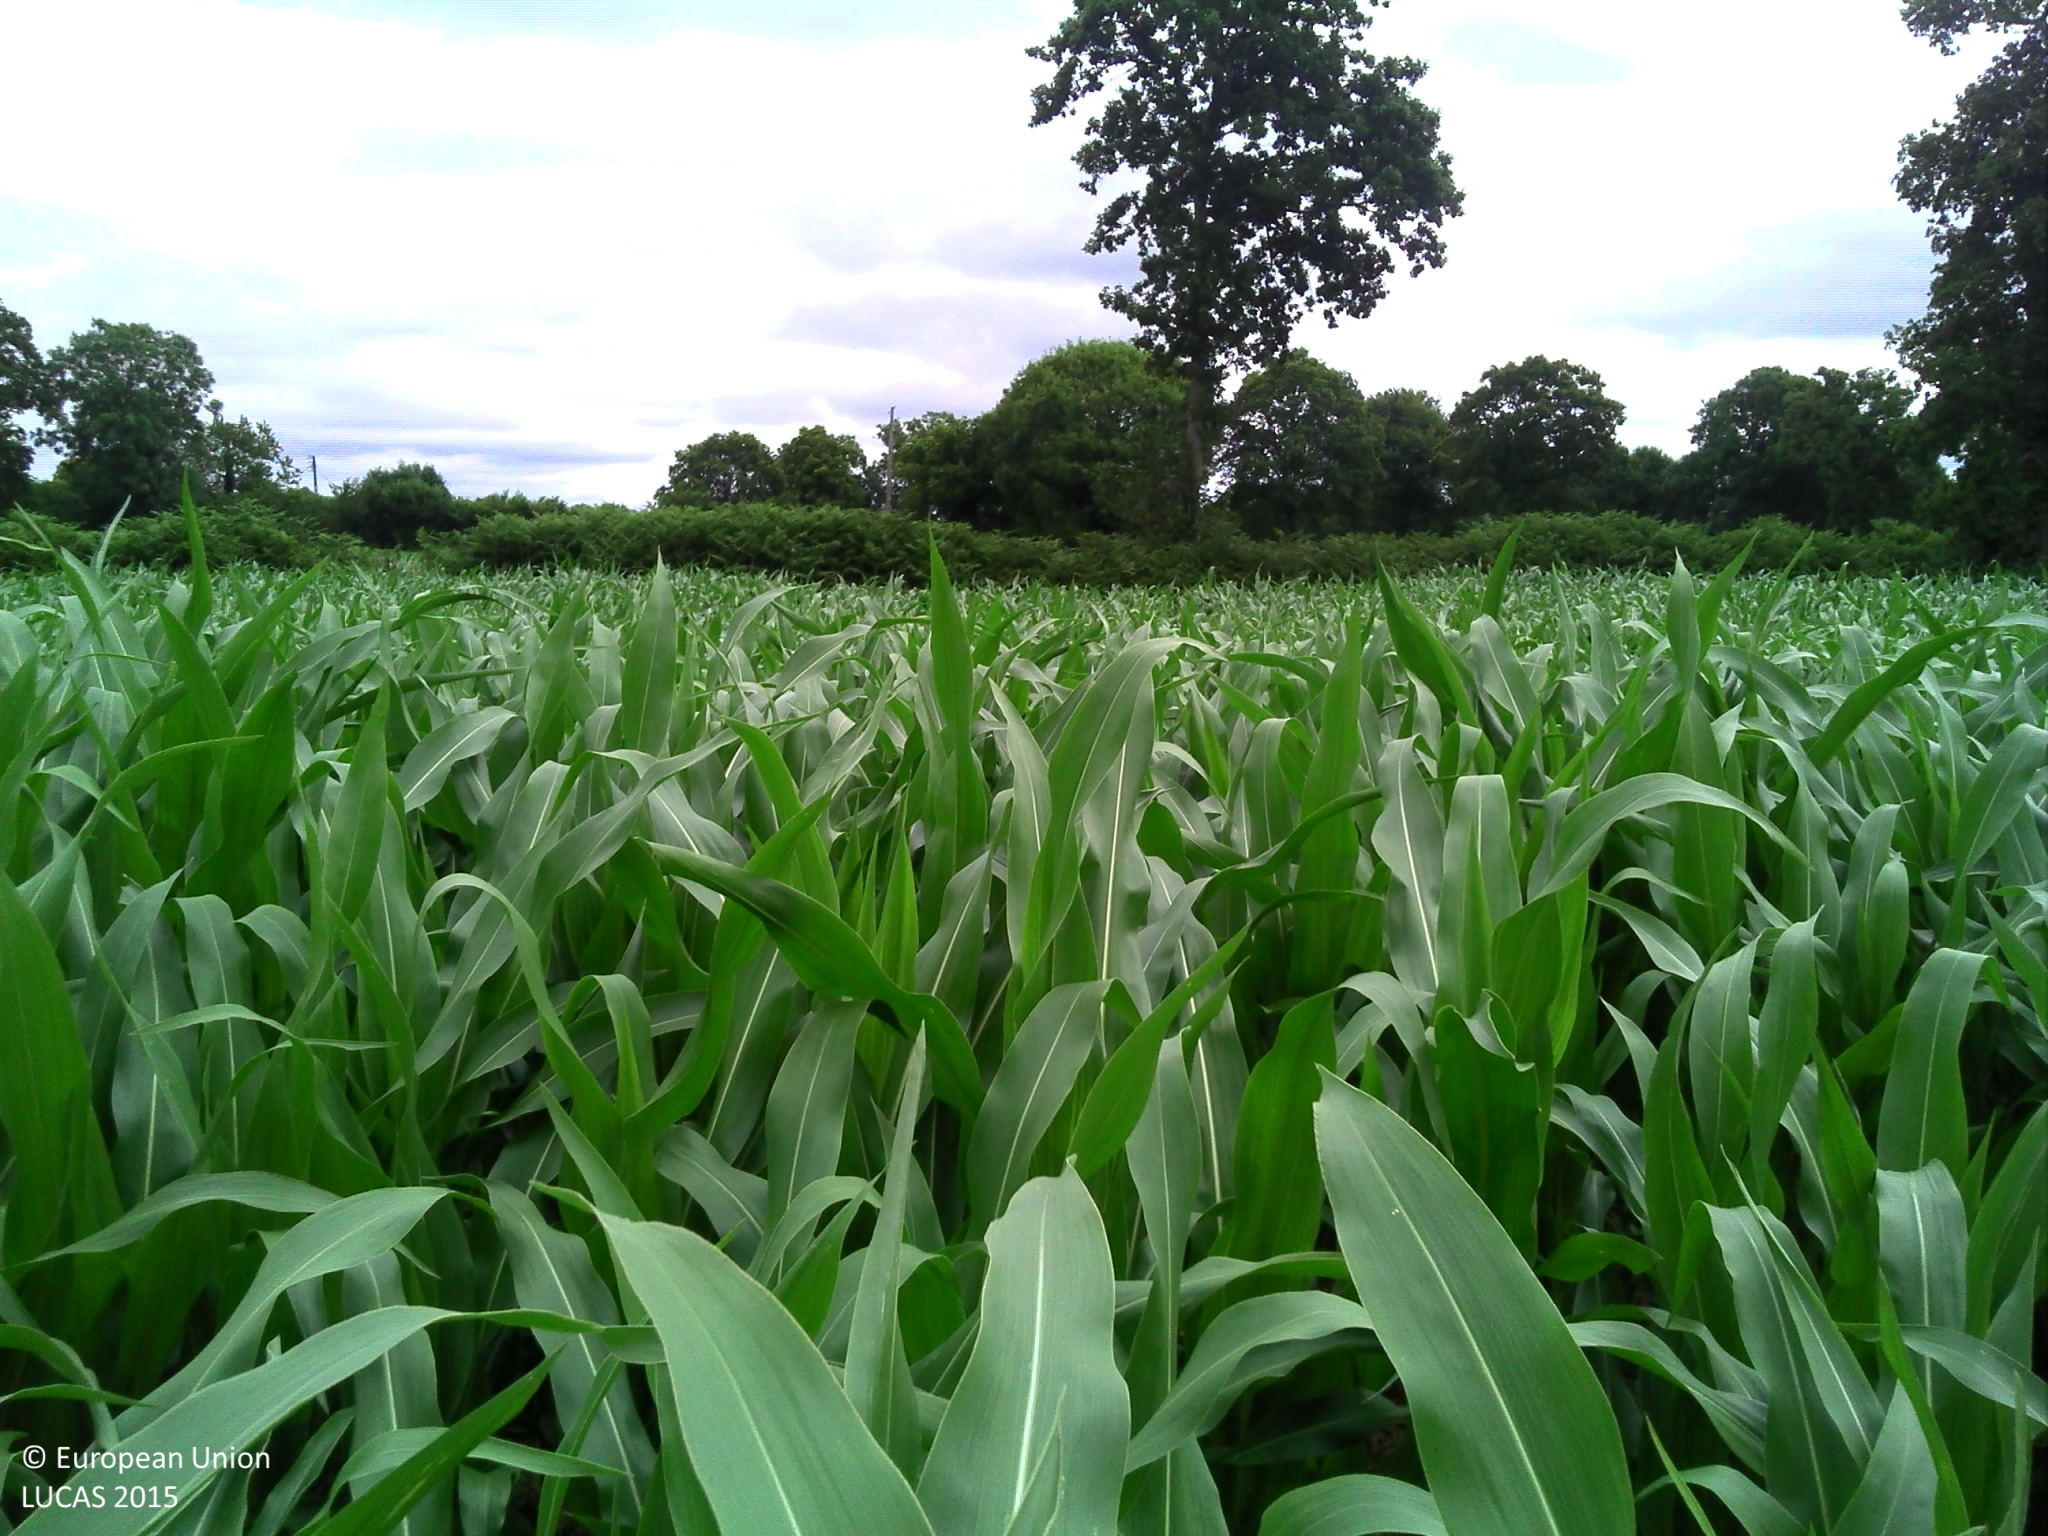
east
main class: Cropland
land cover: Maize
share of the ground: > 75 %
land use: Agriculture (excluding fallow land and kitchen gardens)
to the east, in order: Maize; Abandoned hedges; Fences; Tracks; Abandoned hedges; Maize; Electric lines; Maize; Broadleaved woodland; Fences; Grassland without tree/shrub cover; Fences; Broadleaved woodland; Maize
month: July
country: FR
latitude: 48.9446
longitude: -1.3377
